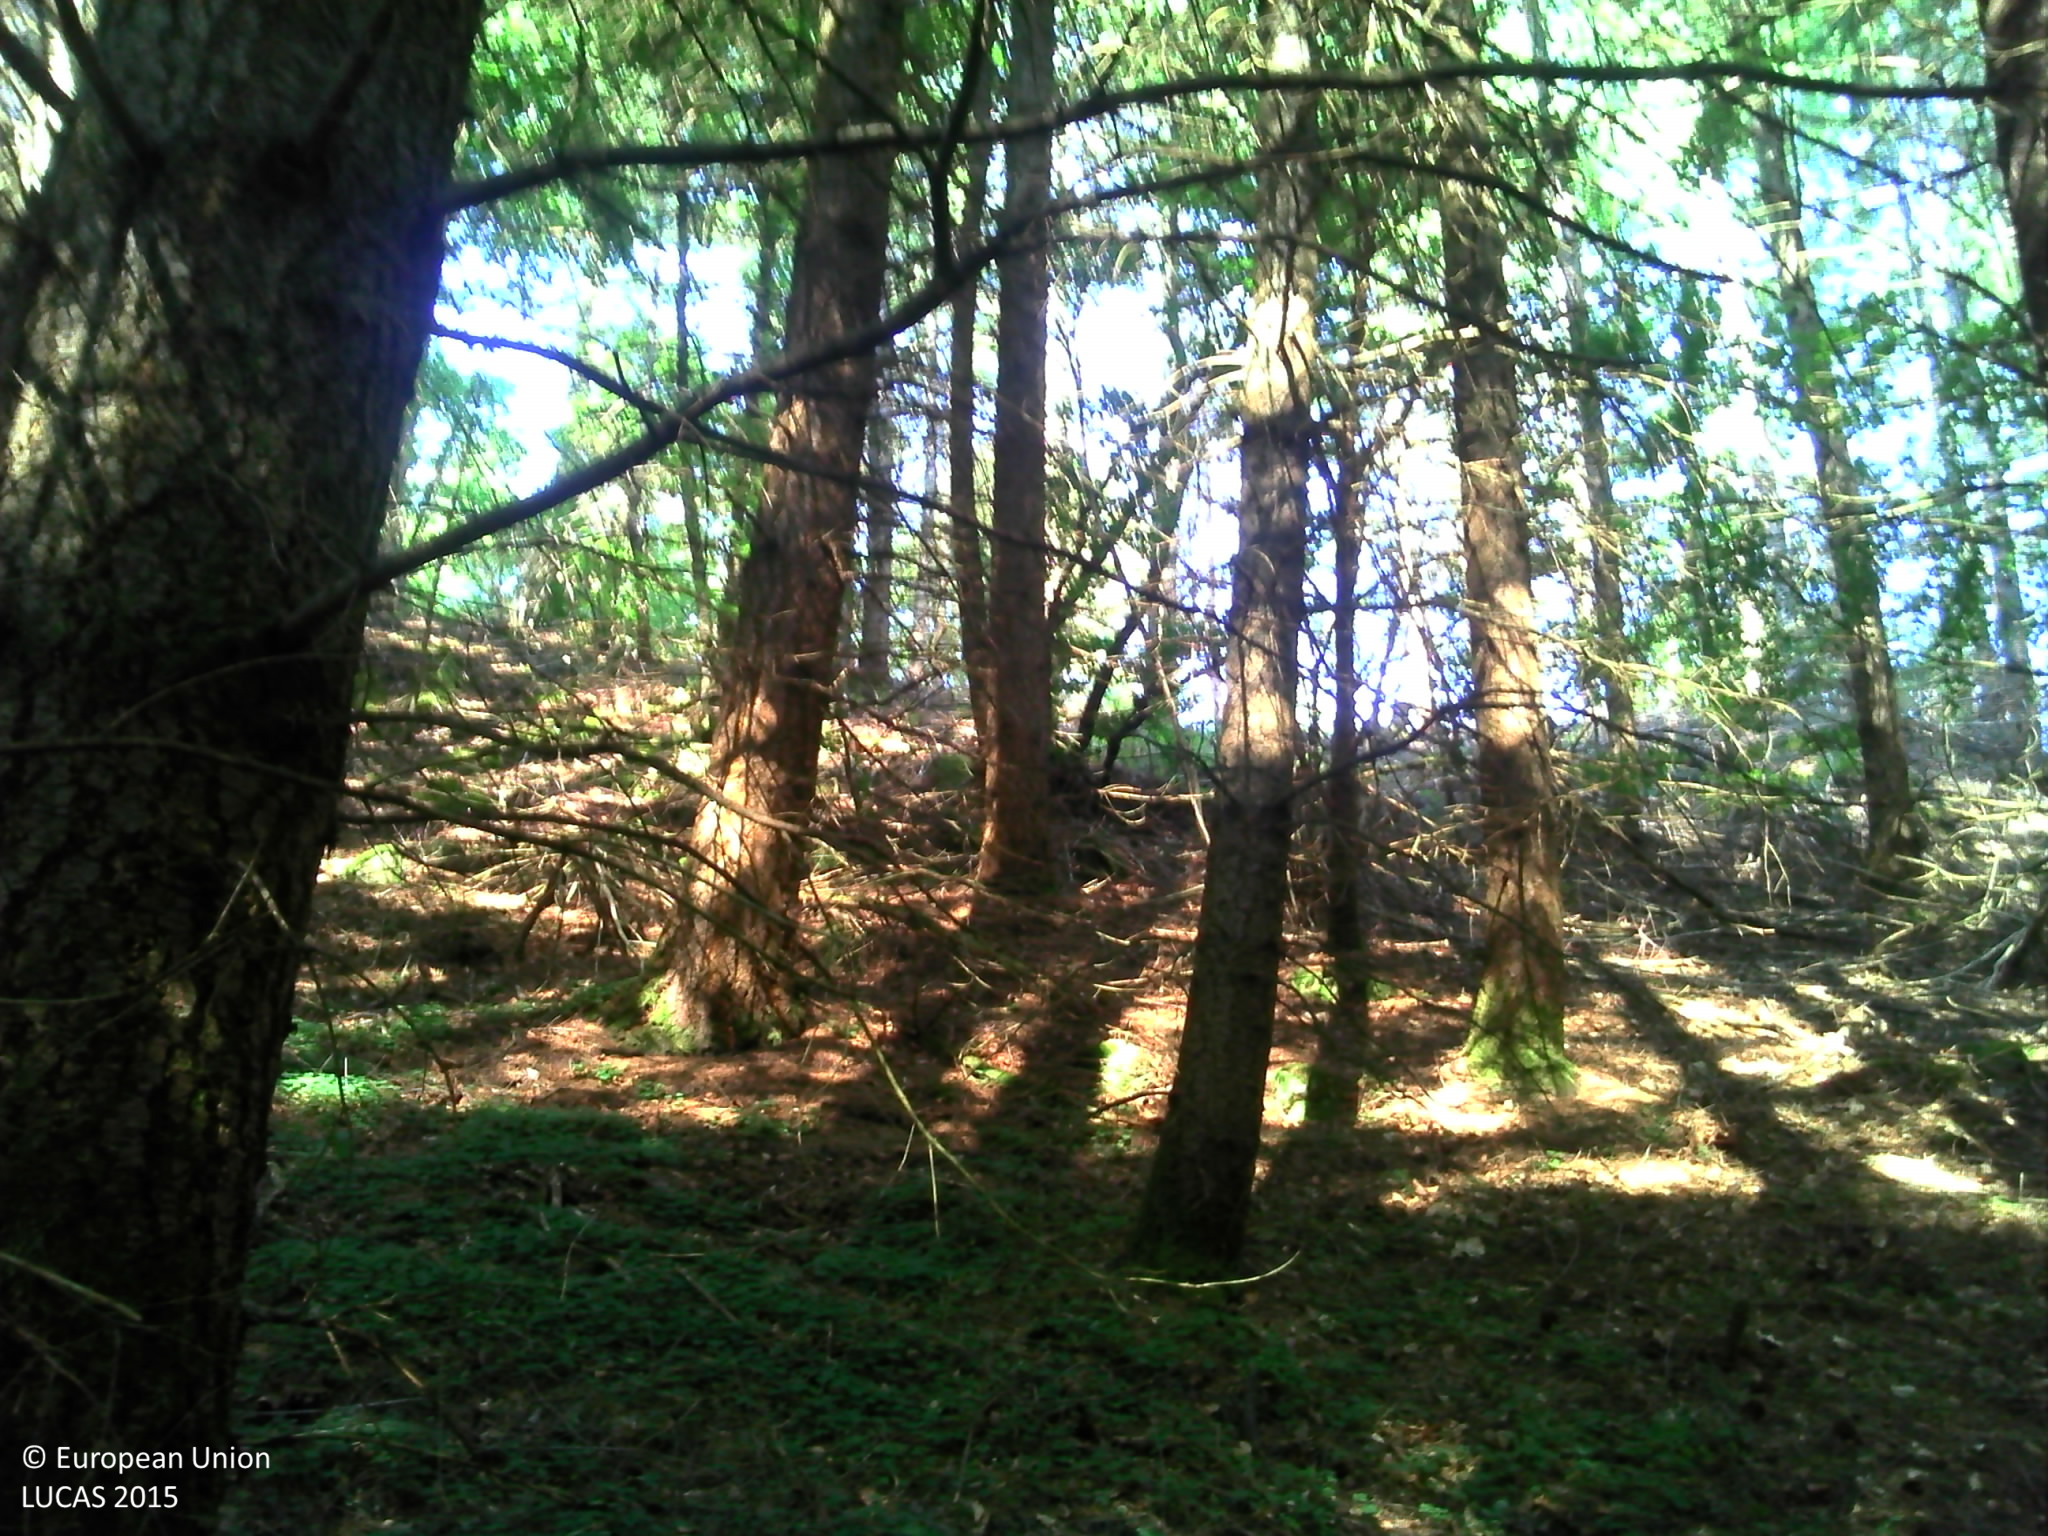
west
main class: Woodland
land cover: Pine dominated mixed woodland
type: beech forest
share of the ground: > 75 %
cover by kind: coniferous forest trees 60 %, broadleaved forest trees 20 %, shrubs 20 %
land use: Forestry
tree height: > 5 m
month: August
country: FR
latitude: 45.2527
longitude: 3.8490
